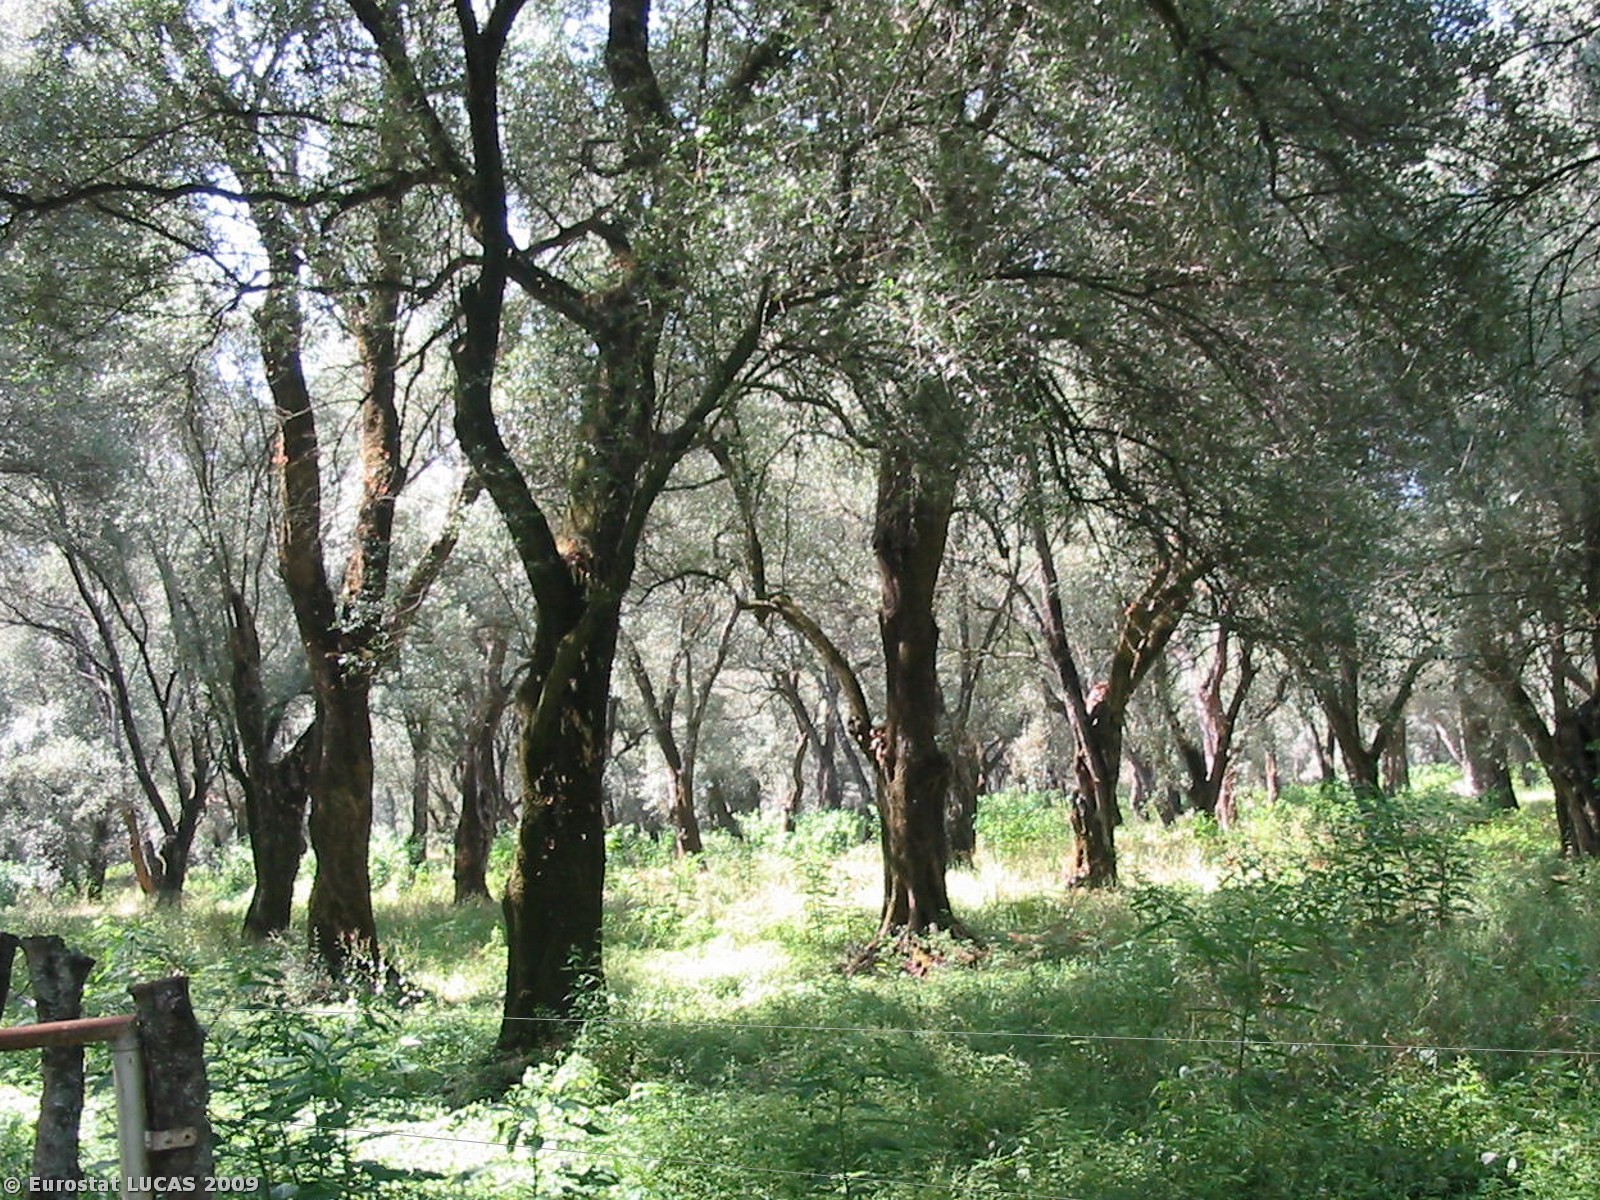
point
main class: Cropland
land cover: Olive groves
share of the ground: 50 - 75 %
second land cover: Spontaneously vegetated surfaces
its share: > 75 %
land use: Agriculture (excluding fallow land and kitchen gardens)
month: July
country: IT
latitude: 38.3723
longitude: 16.0650
